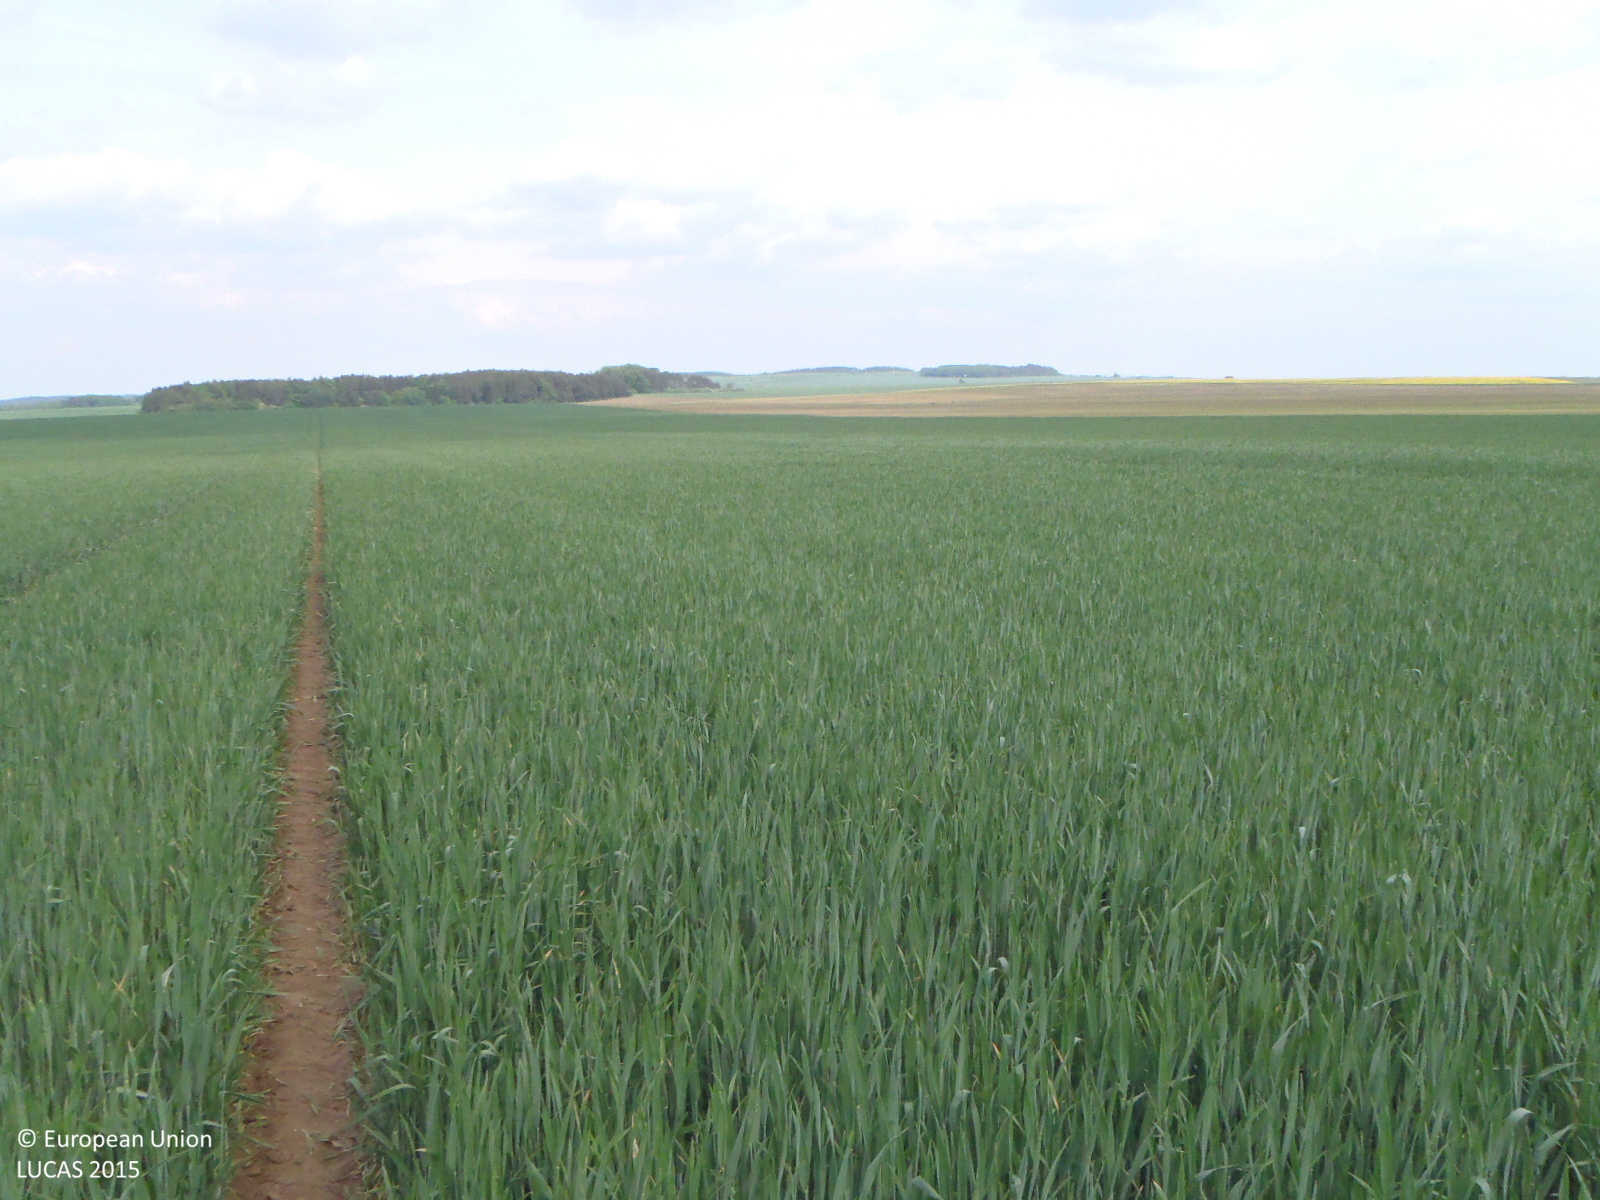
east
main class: Cropland
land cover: Common wheat
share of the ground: > 75 %
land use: Agriculture (excluding fallow land and kitchen gardens)
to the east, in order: Common wheat
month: May
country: CZ
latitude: 48.9143
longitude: 15.5297
